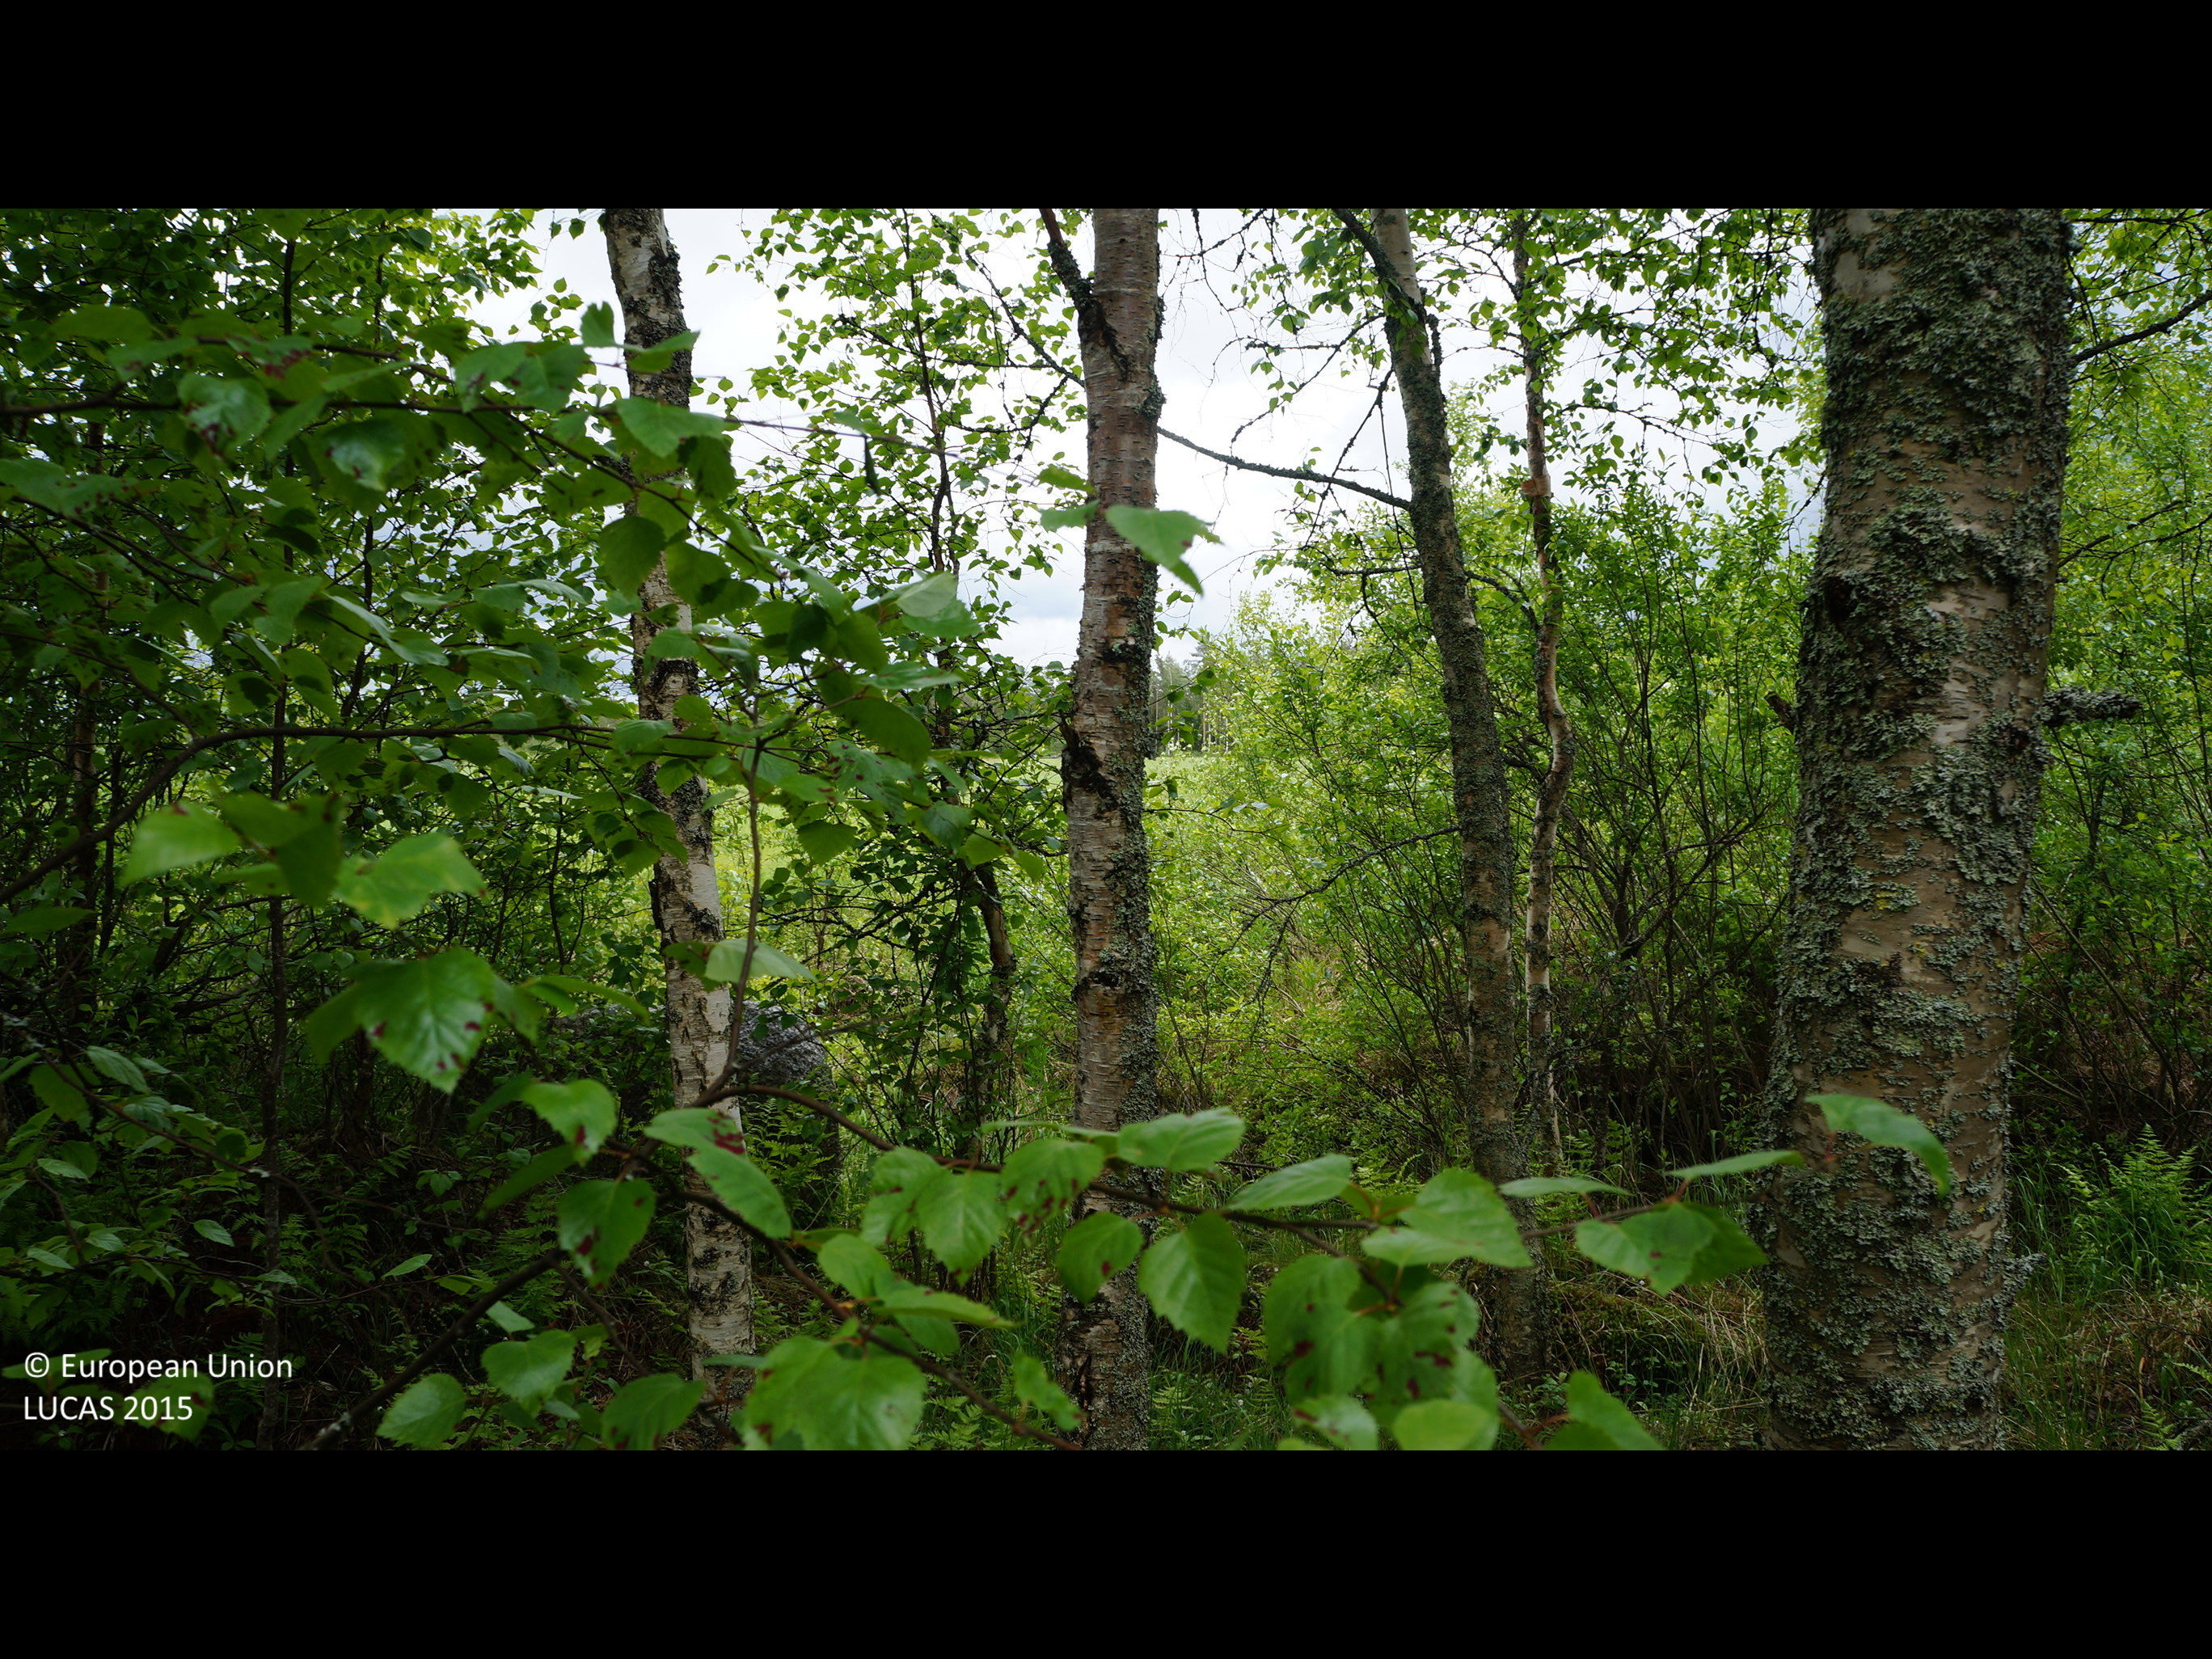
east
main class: Woodland
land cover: Broadleaved woodland
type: non-riverine alder, birch or aspen forest
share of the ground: > 75 %
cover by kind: broadleaved forest trees 90 %, shrubs 5 %, herbaceous plants 5 %
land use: Forestry
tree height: > 5 m
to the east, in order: Broadleaved woodland; Ditches and canals; Shrubland without tree cover; Ditches and canals; Temporary grasslands; Grass margins; Barley
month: June
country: FI
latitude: 63.9888
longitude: 25.2343
